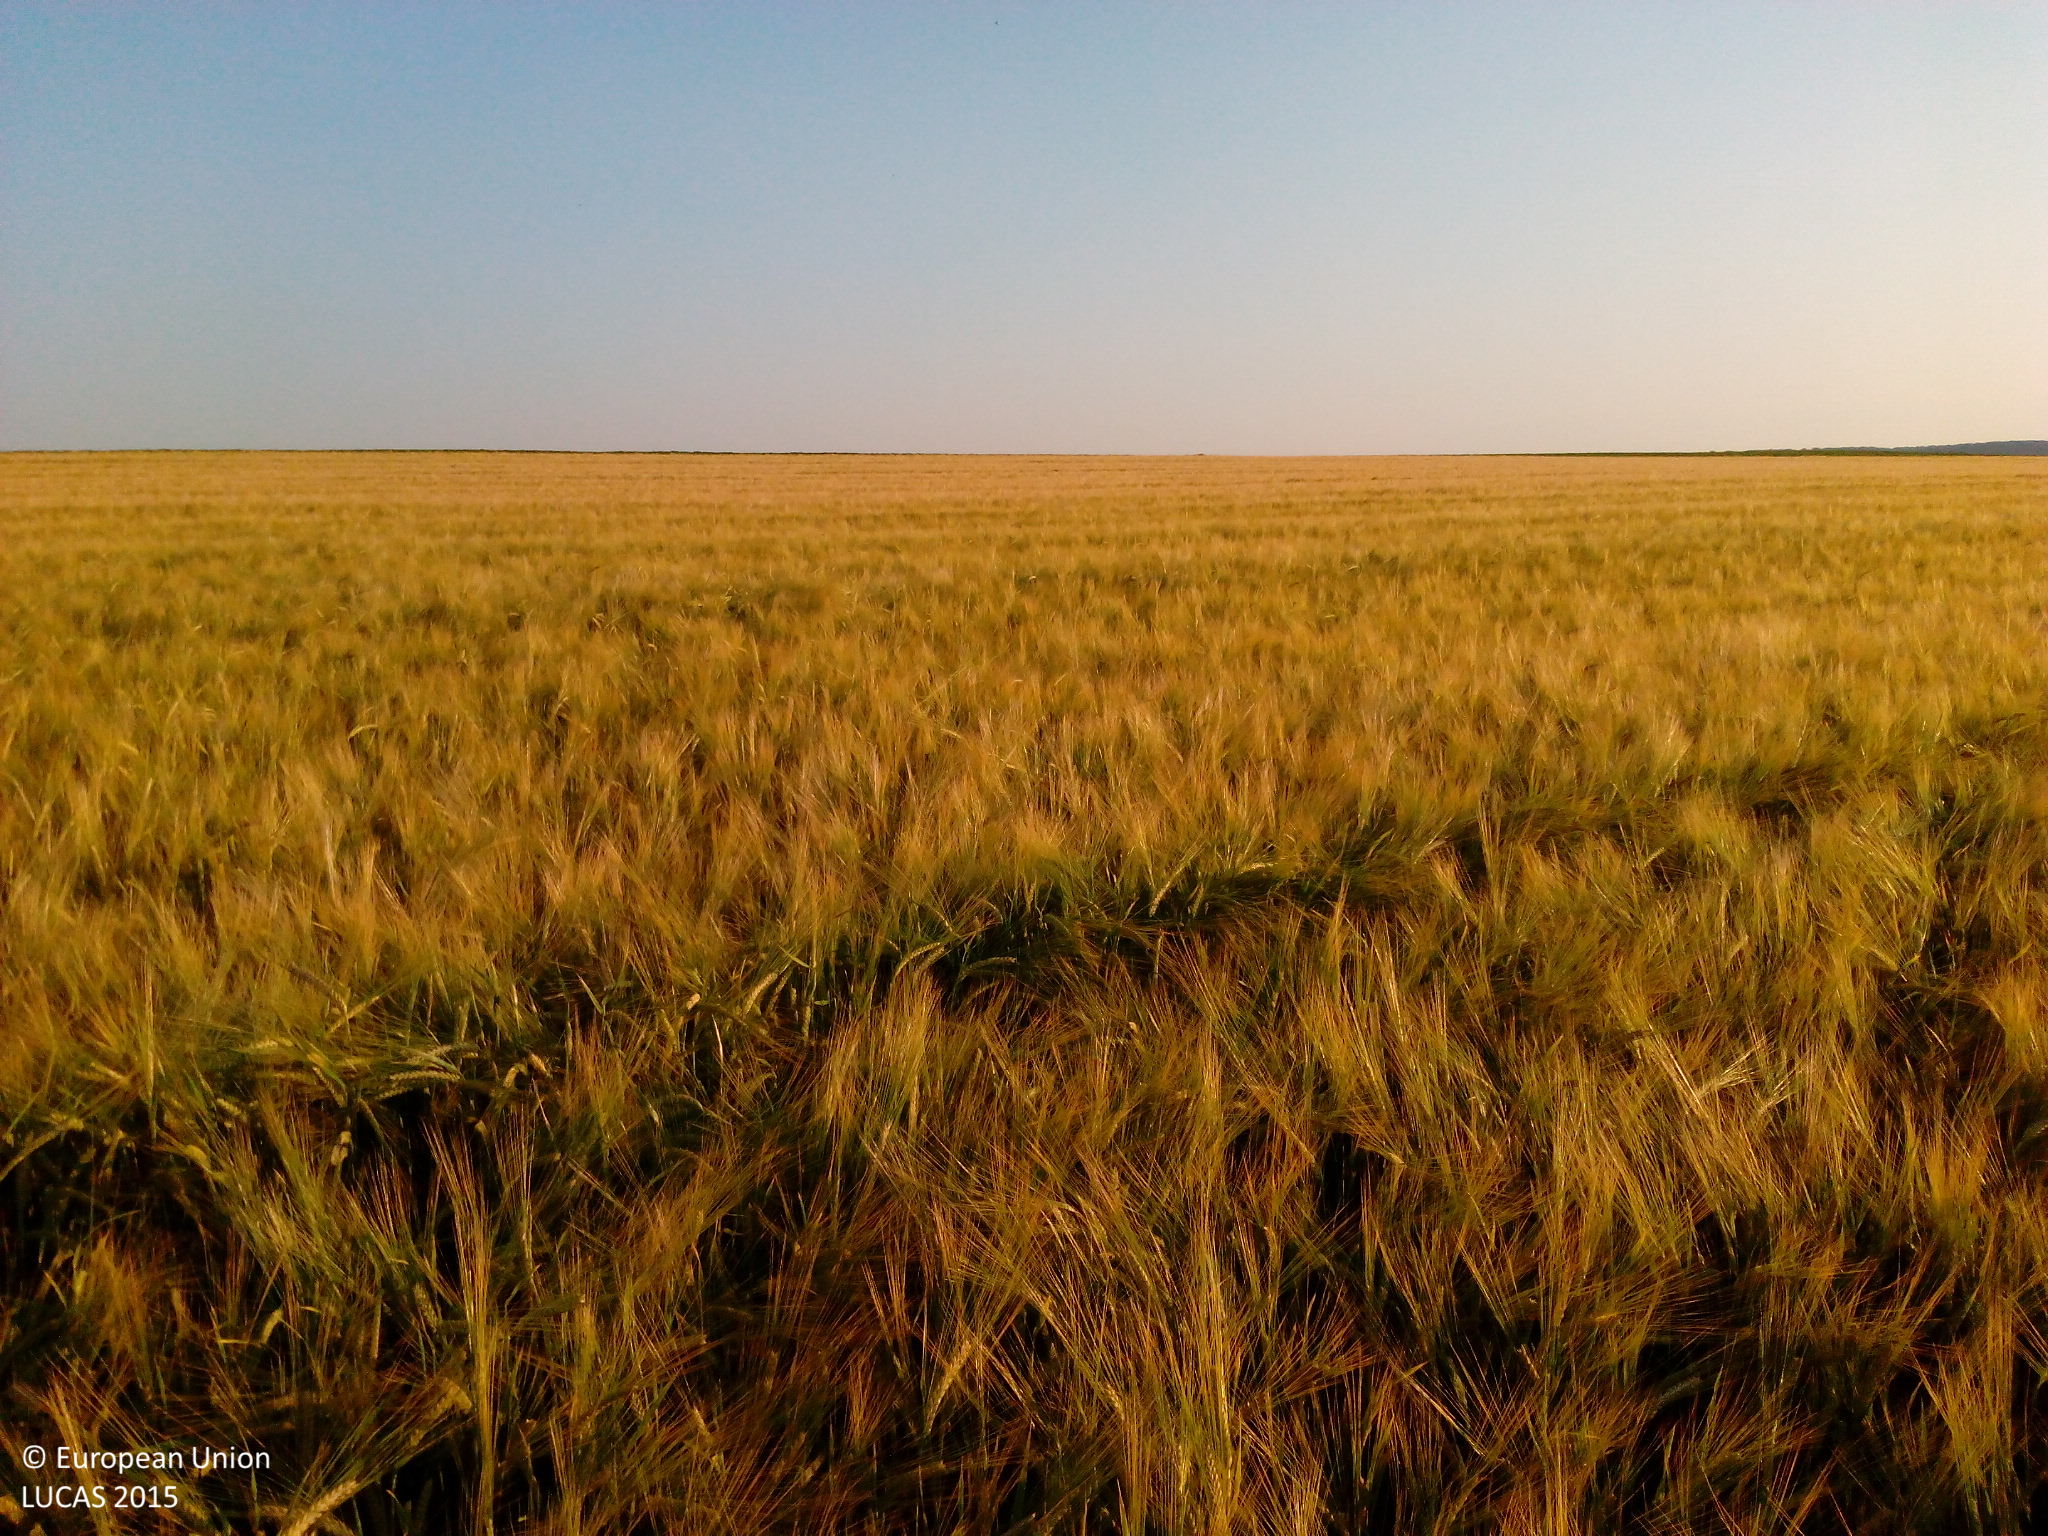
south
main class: Cropland
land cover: Barley
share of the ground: > 75 %
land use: Agriculture (excluding fallow land and kitchen gardens)
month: July
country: DE
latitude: 49.6087
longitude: 9.9032
